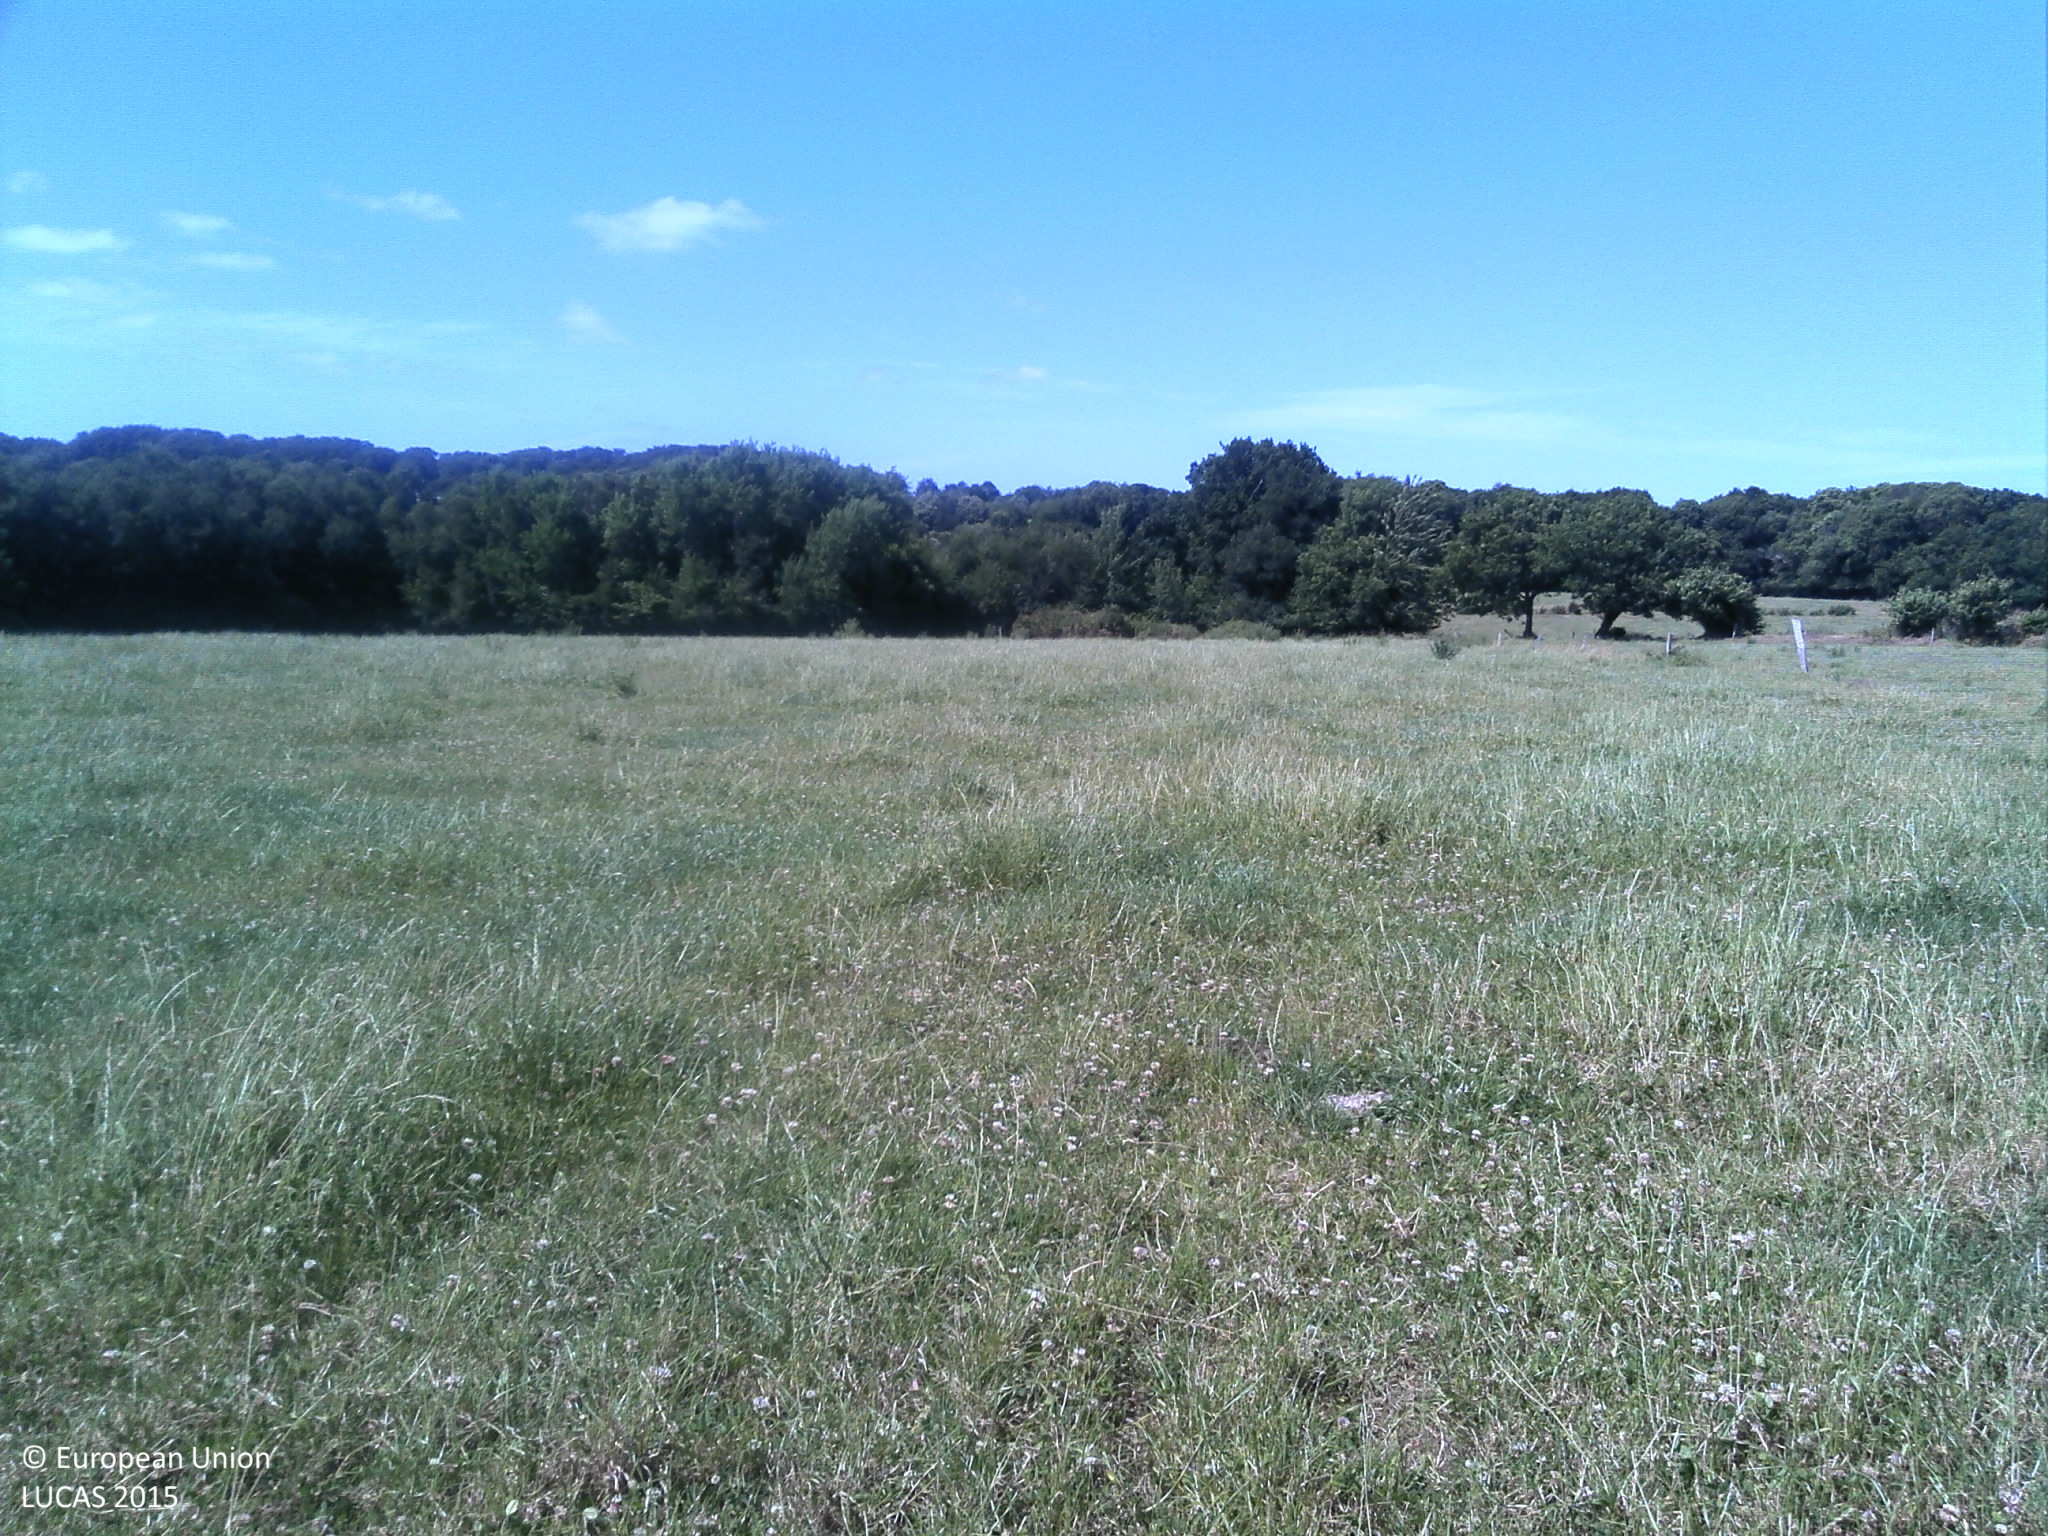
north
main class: Grassland
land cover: Grassland without tree/shrub cover
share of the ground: > 75 %
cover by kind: herbaceous plants 100 %
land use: Agriculture (excluding fallow land and kitchen gardens)
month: July
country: FR
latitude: 48.6168
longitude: -3.7440
